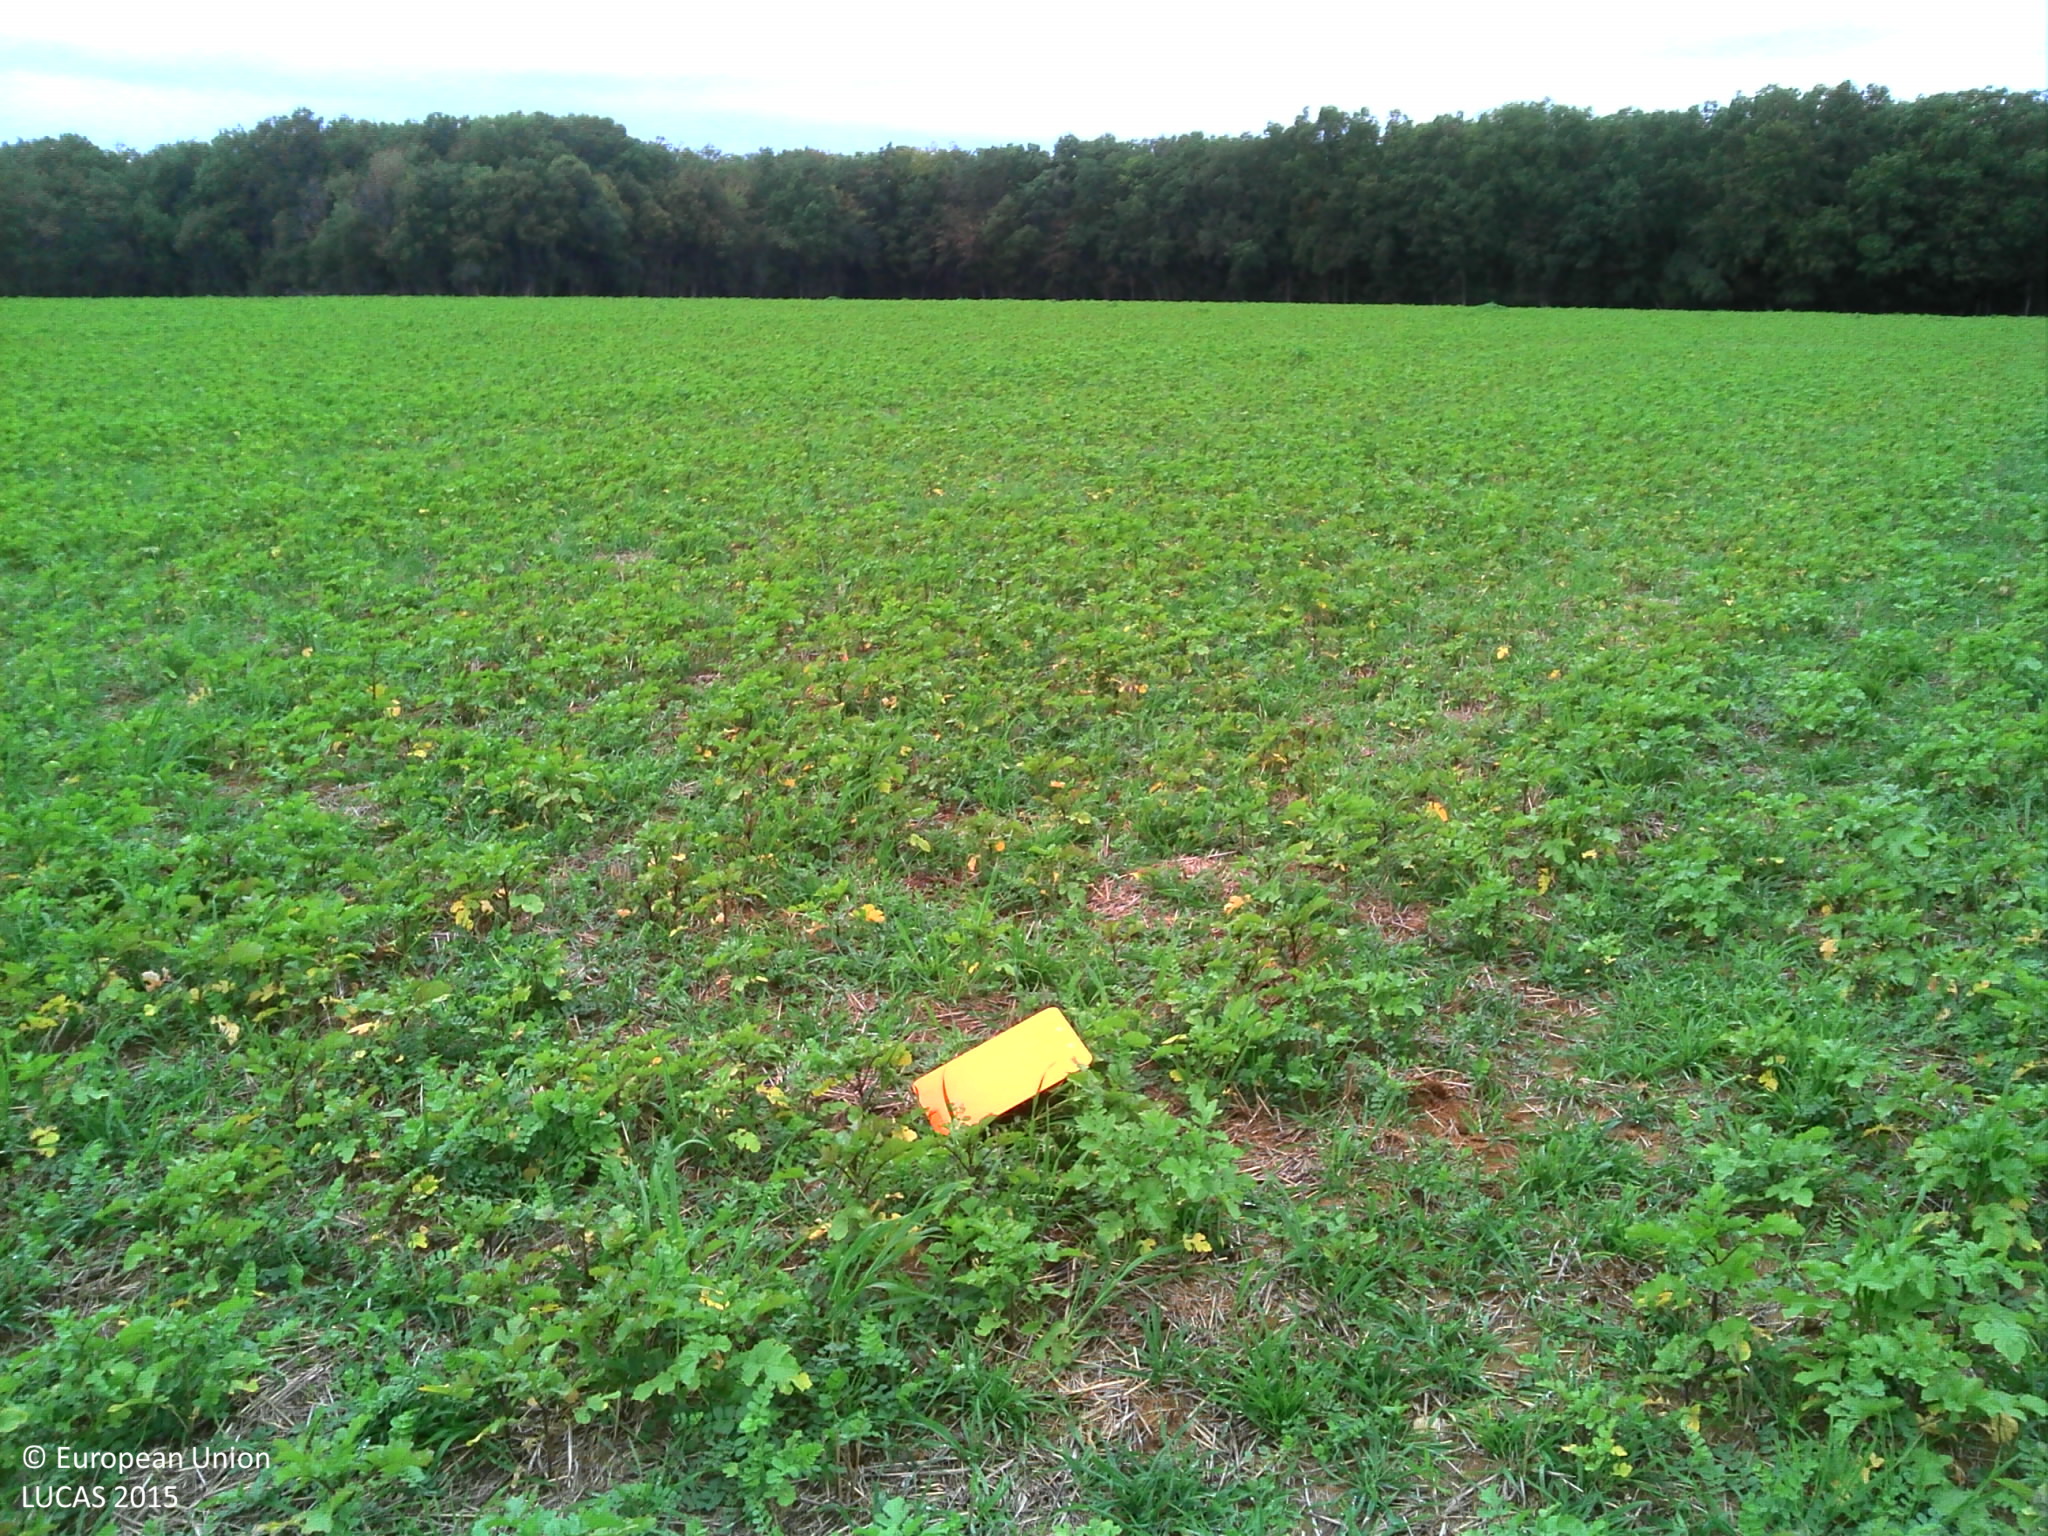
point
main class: Cropland
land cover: Other fibre and oleaginous crops
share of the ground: > 75 %
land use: Agriculture (excluding fallow land and kitchen gardens)
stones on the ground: < 10 %
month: October
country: FR
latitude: 48.0951
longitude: 4.3177
